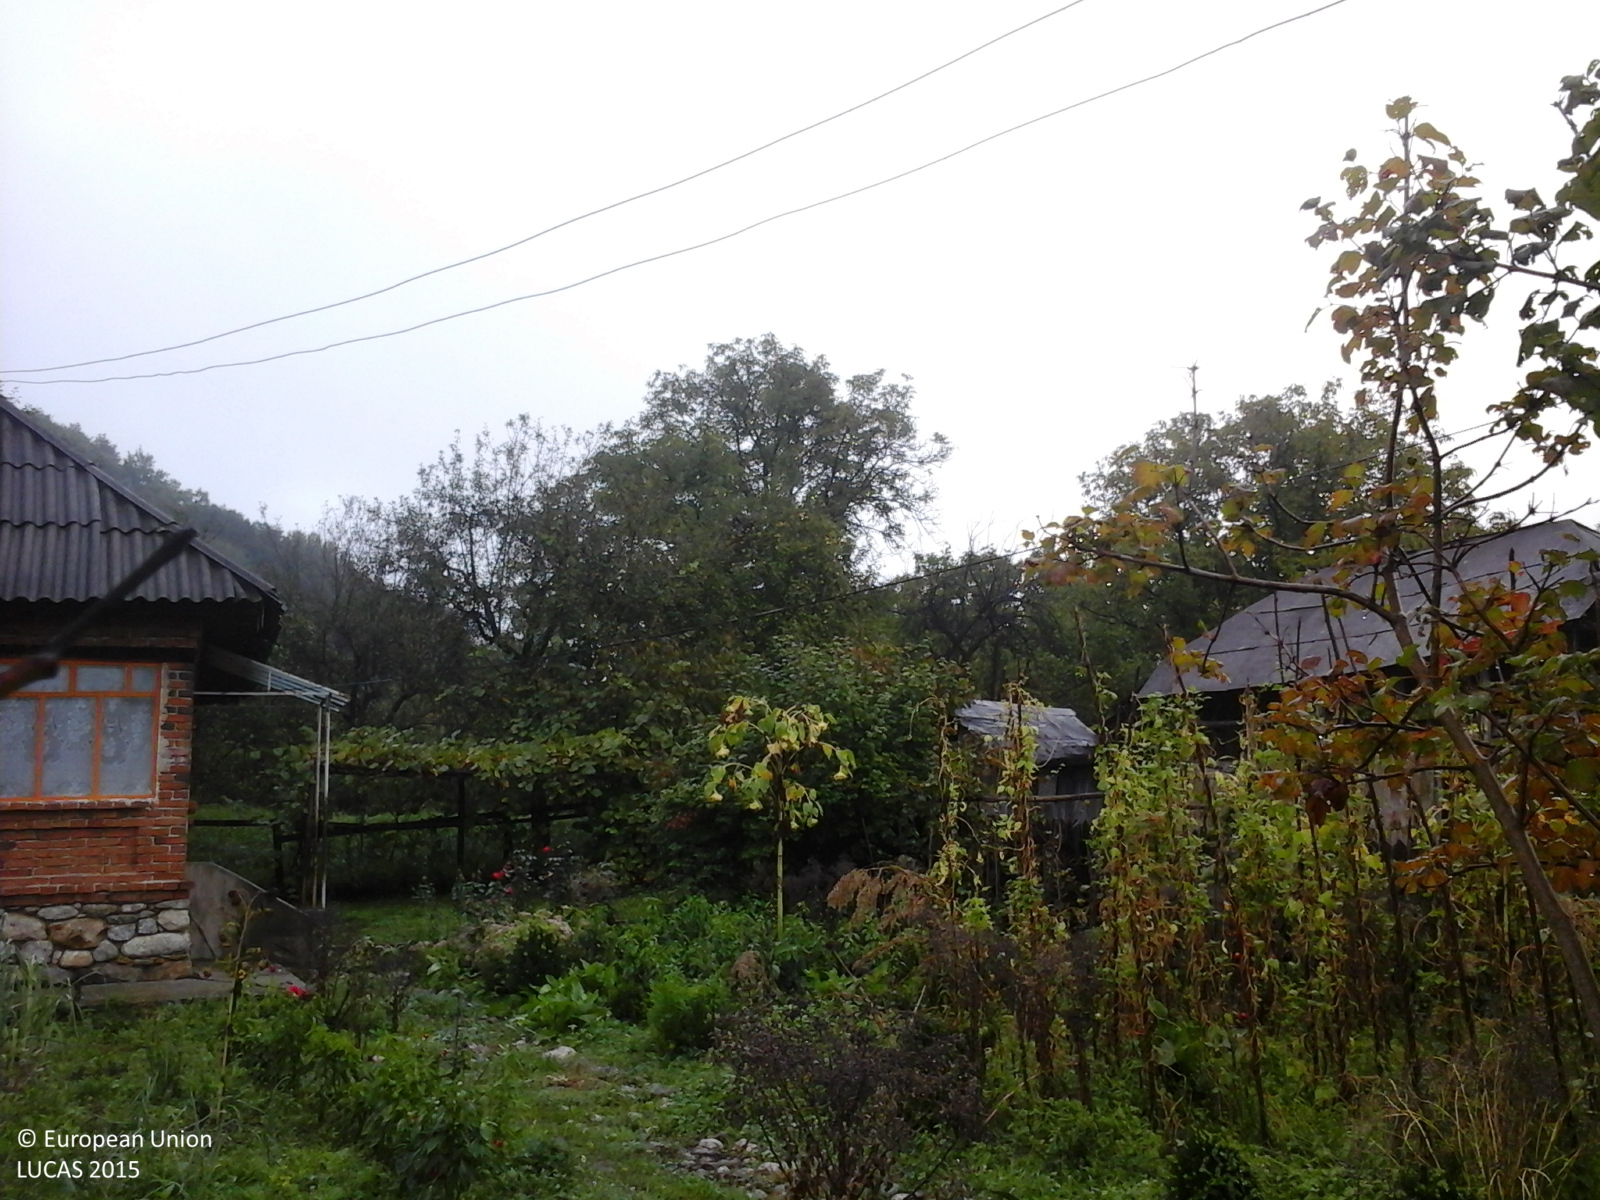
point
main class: Cropland
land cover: Apple fruit
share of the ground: 50 - 75 %
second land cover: Grassland without tree/shrub cover
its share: > 75 %
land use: Agriculture (excluding fallow land and kitchen gardens)
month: September
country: RO
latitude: 45.1129
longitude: 24.0109
